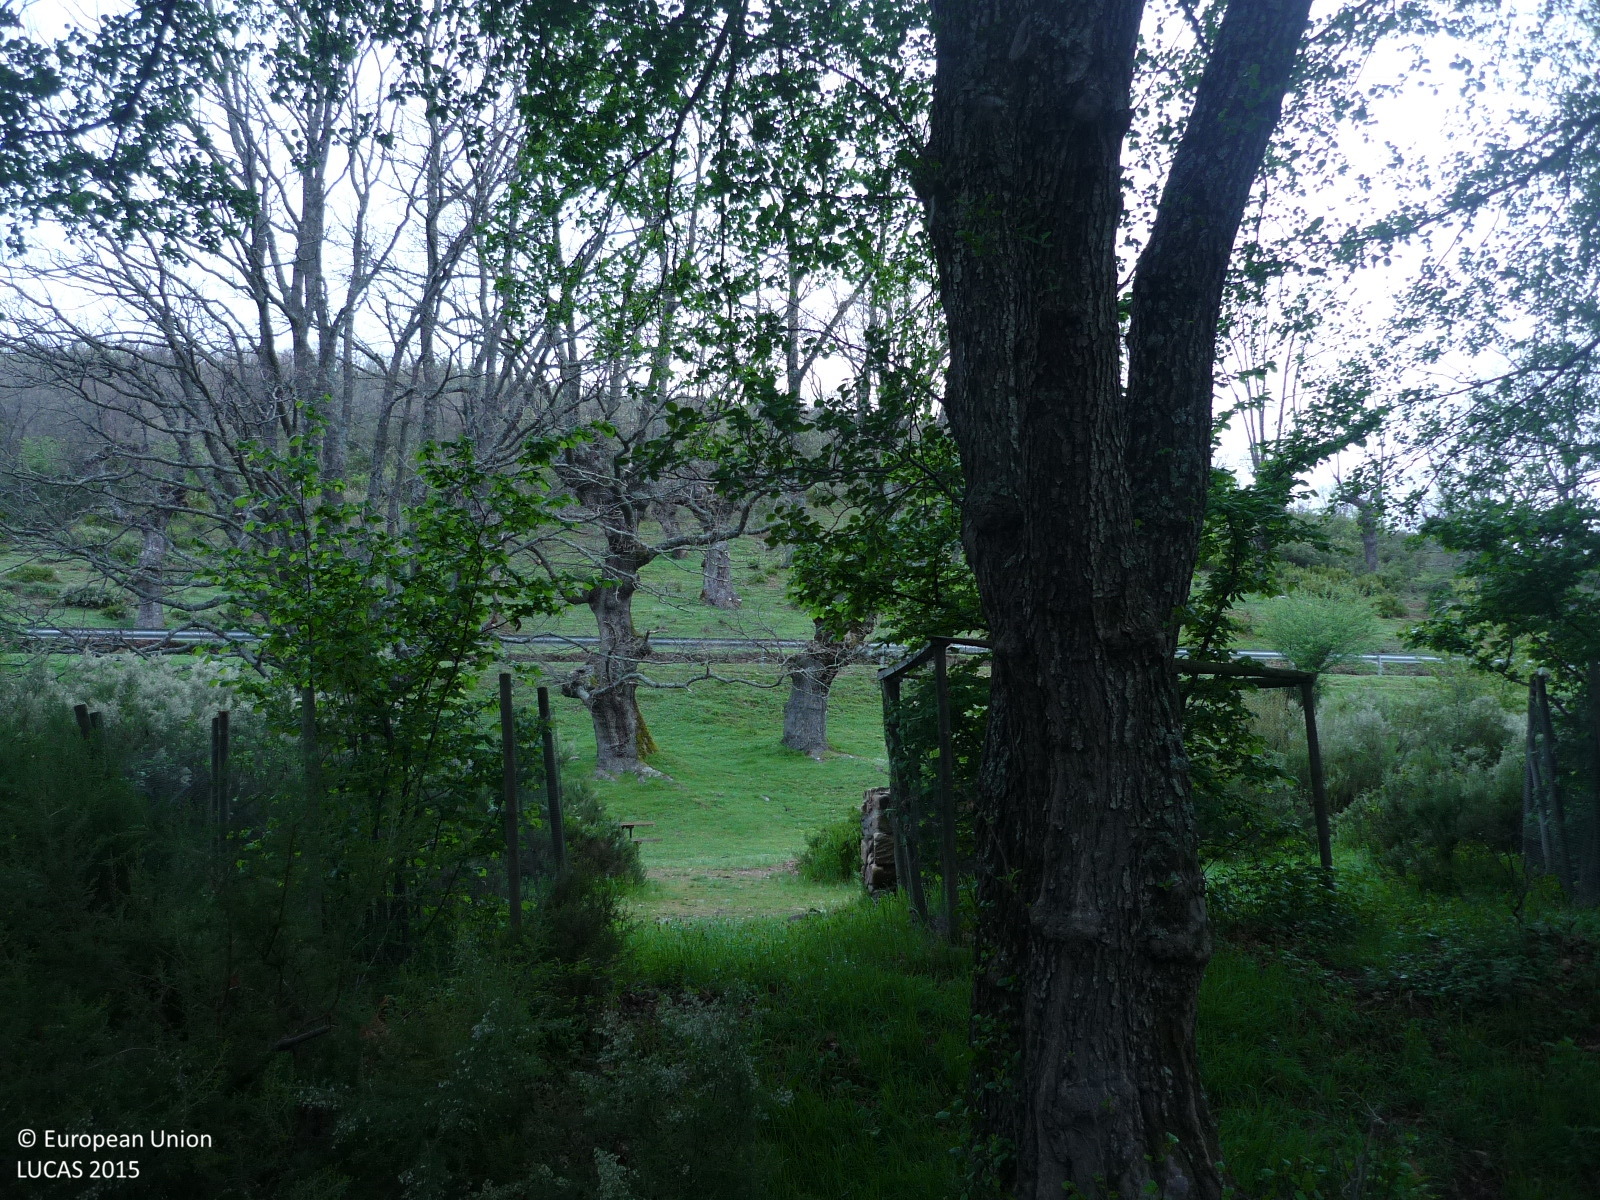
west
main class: Woodland
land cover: Broadleaved woodland
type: floodplain forest
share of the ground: > 75 %
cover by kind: broadleaved forest trees 85 %, shrubs 10 %, herbaceous plants 5 %
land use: Amenities, museums, leisure
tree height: < 5 m
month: May
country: ES
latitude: 41.0038
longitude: -3.4405
